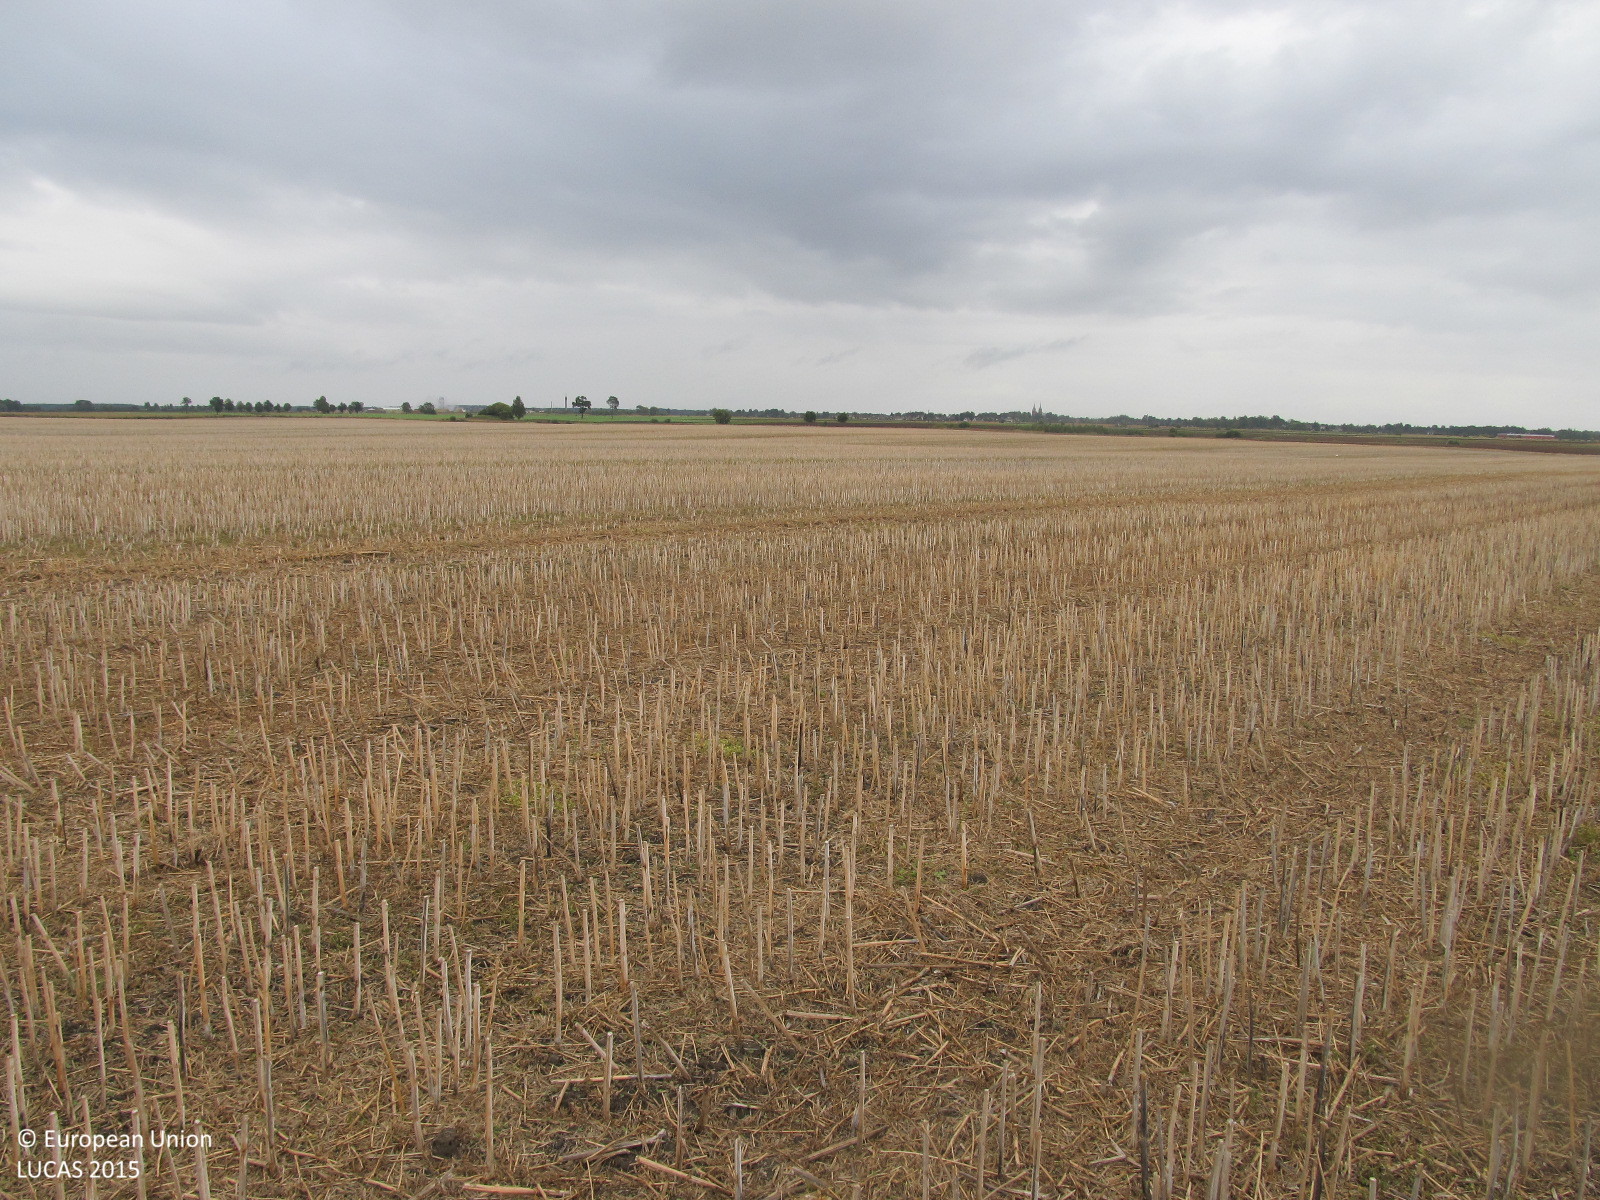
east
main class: Cropland
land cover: Rape and turnip rape
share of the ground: > 75 %
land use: Agriculture (excluding fallow land and kitchen gardens)
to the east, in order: Rape and turnip rape
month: September
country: LT
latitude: 56.1034
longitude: 23.2067
